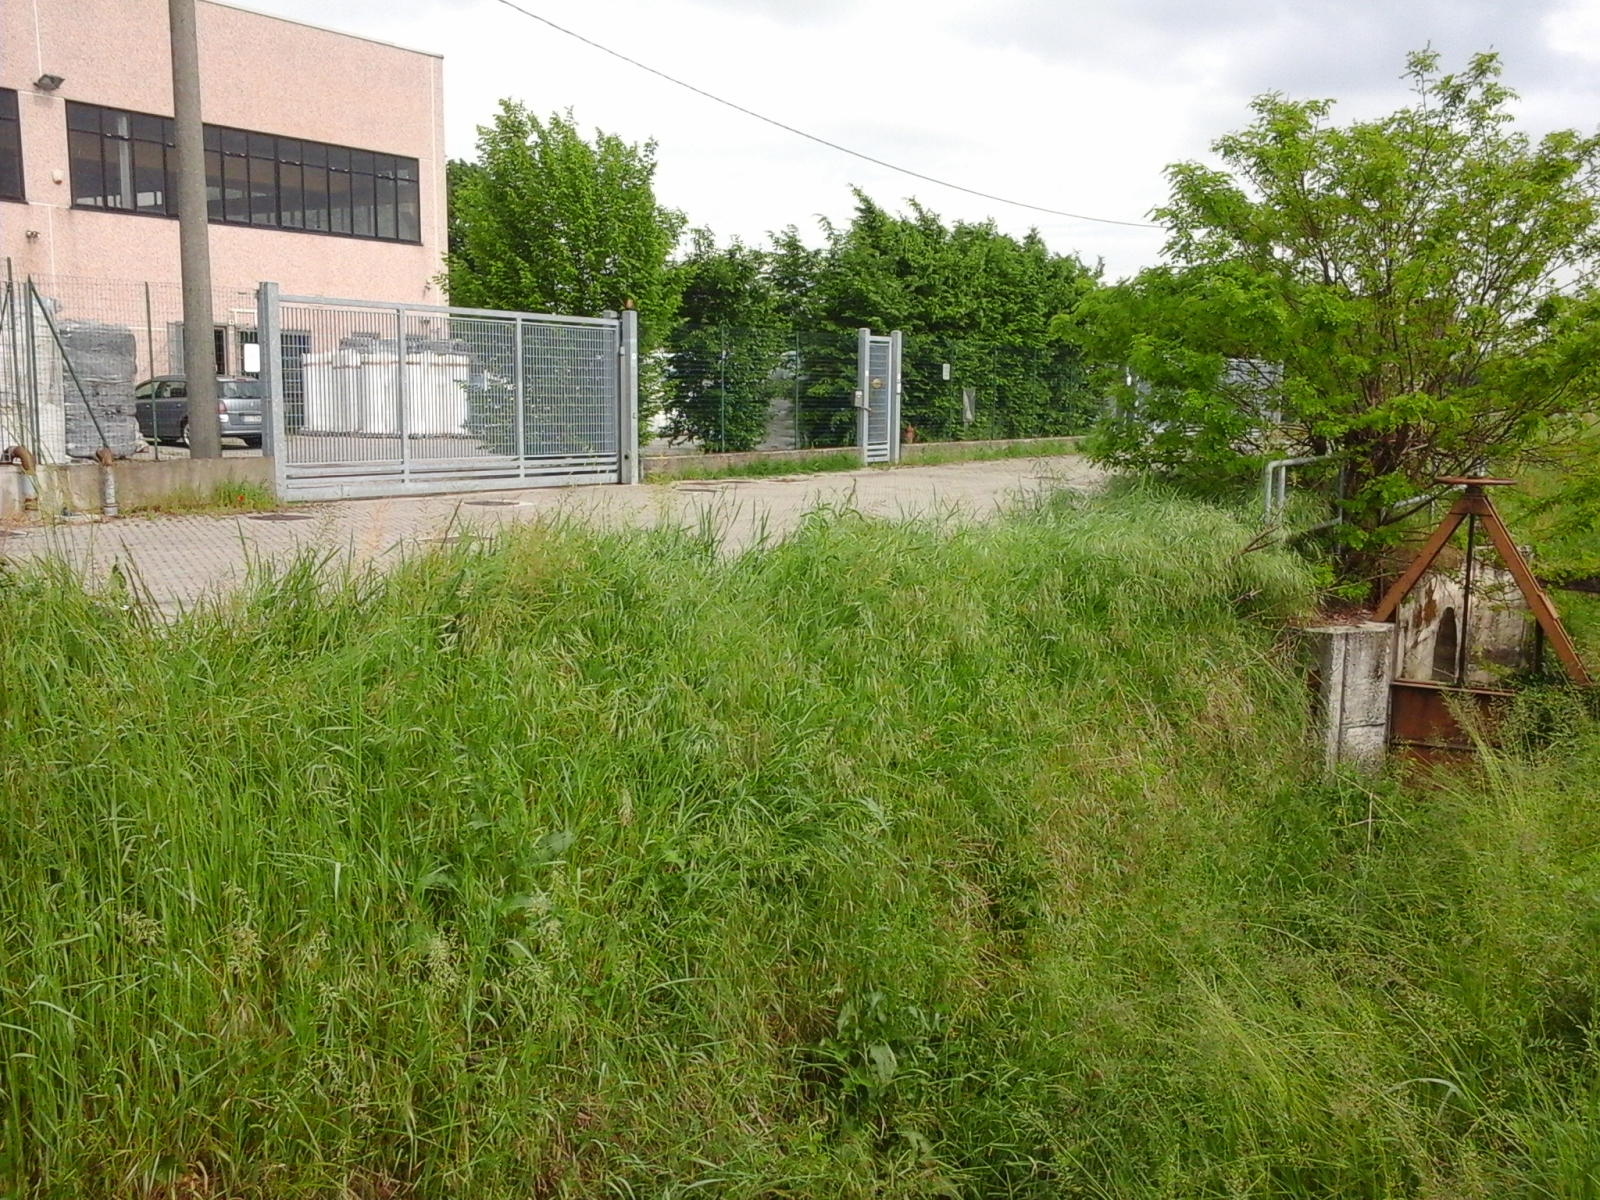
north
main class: Cropland
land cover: Temporary grasslands
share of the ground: > 75 %
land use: Agriculture (excluding fallow land and kitchen gardens)
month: April
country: IT
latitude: 45.1434
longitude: 9.6827
